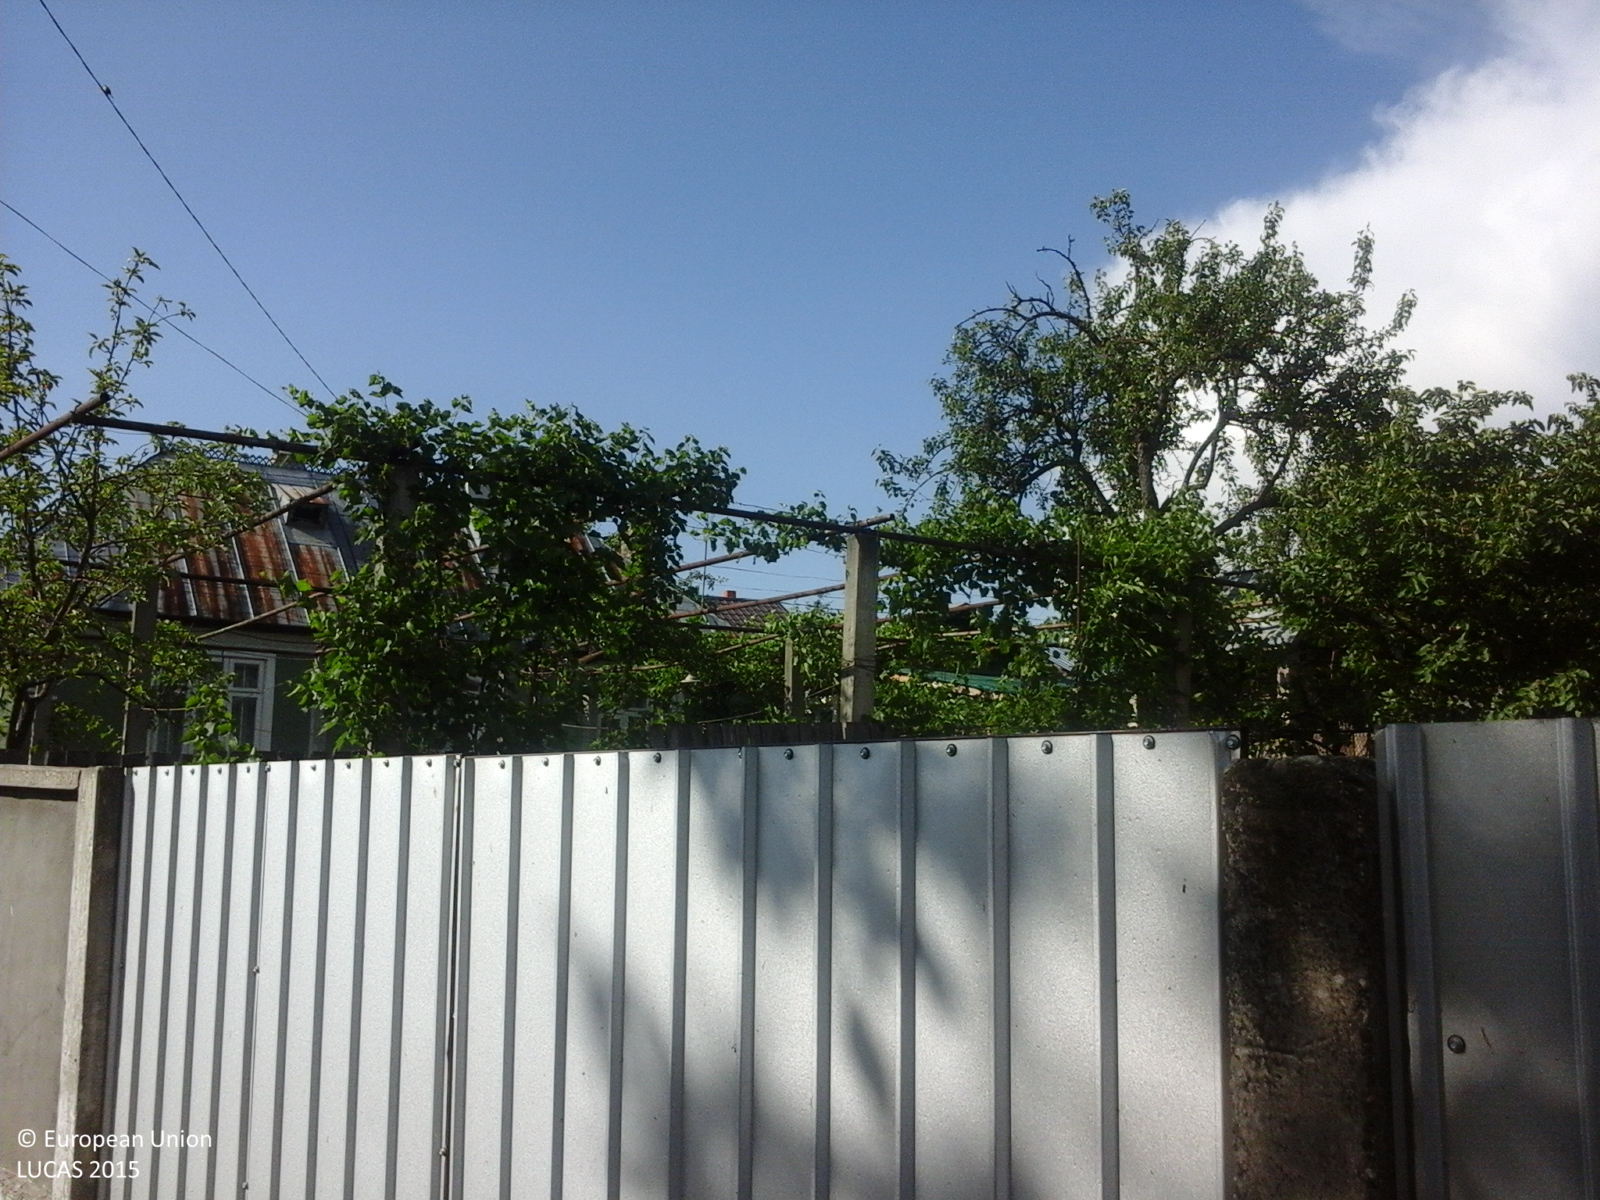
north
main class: Grassland
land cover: Grassland without tree/shrub cover
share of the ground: 50 - 75 %
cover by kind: herbaceous plants 100 %
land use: Agriculture (excluding fallow land and kitchen gardens)
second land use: Residential
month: June
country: RO
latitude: 46.6634
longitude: 26.8074
